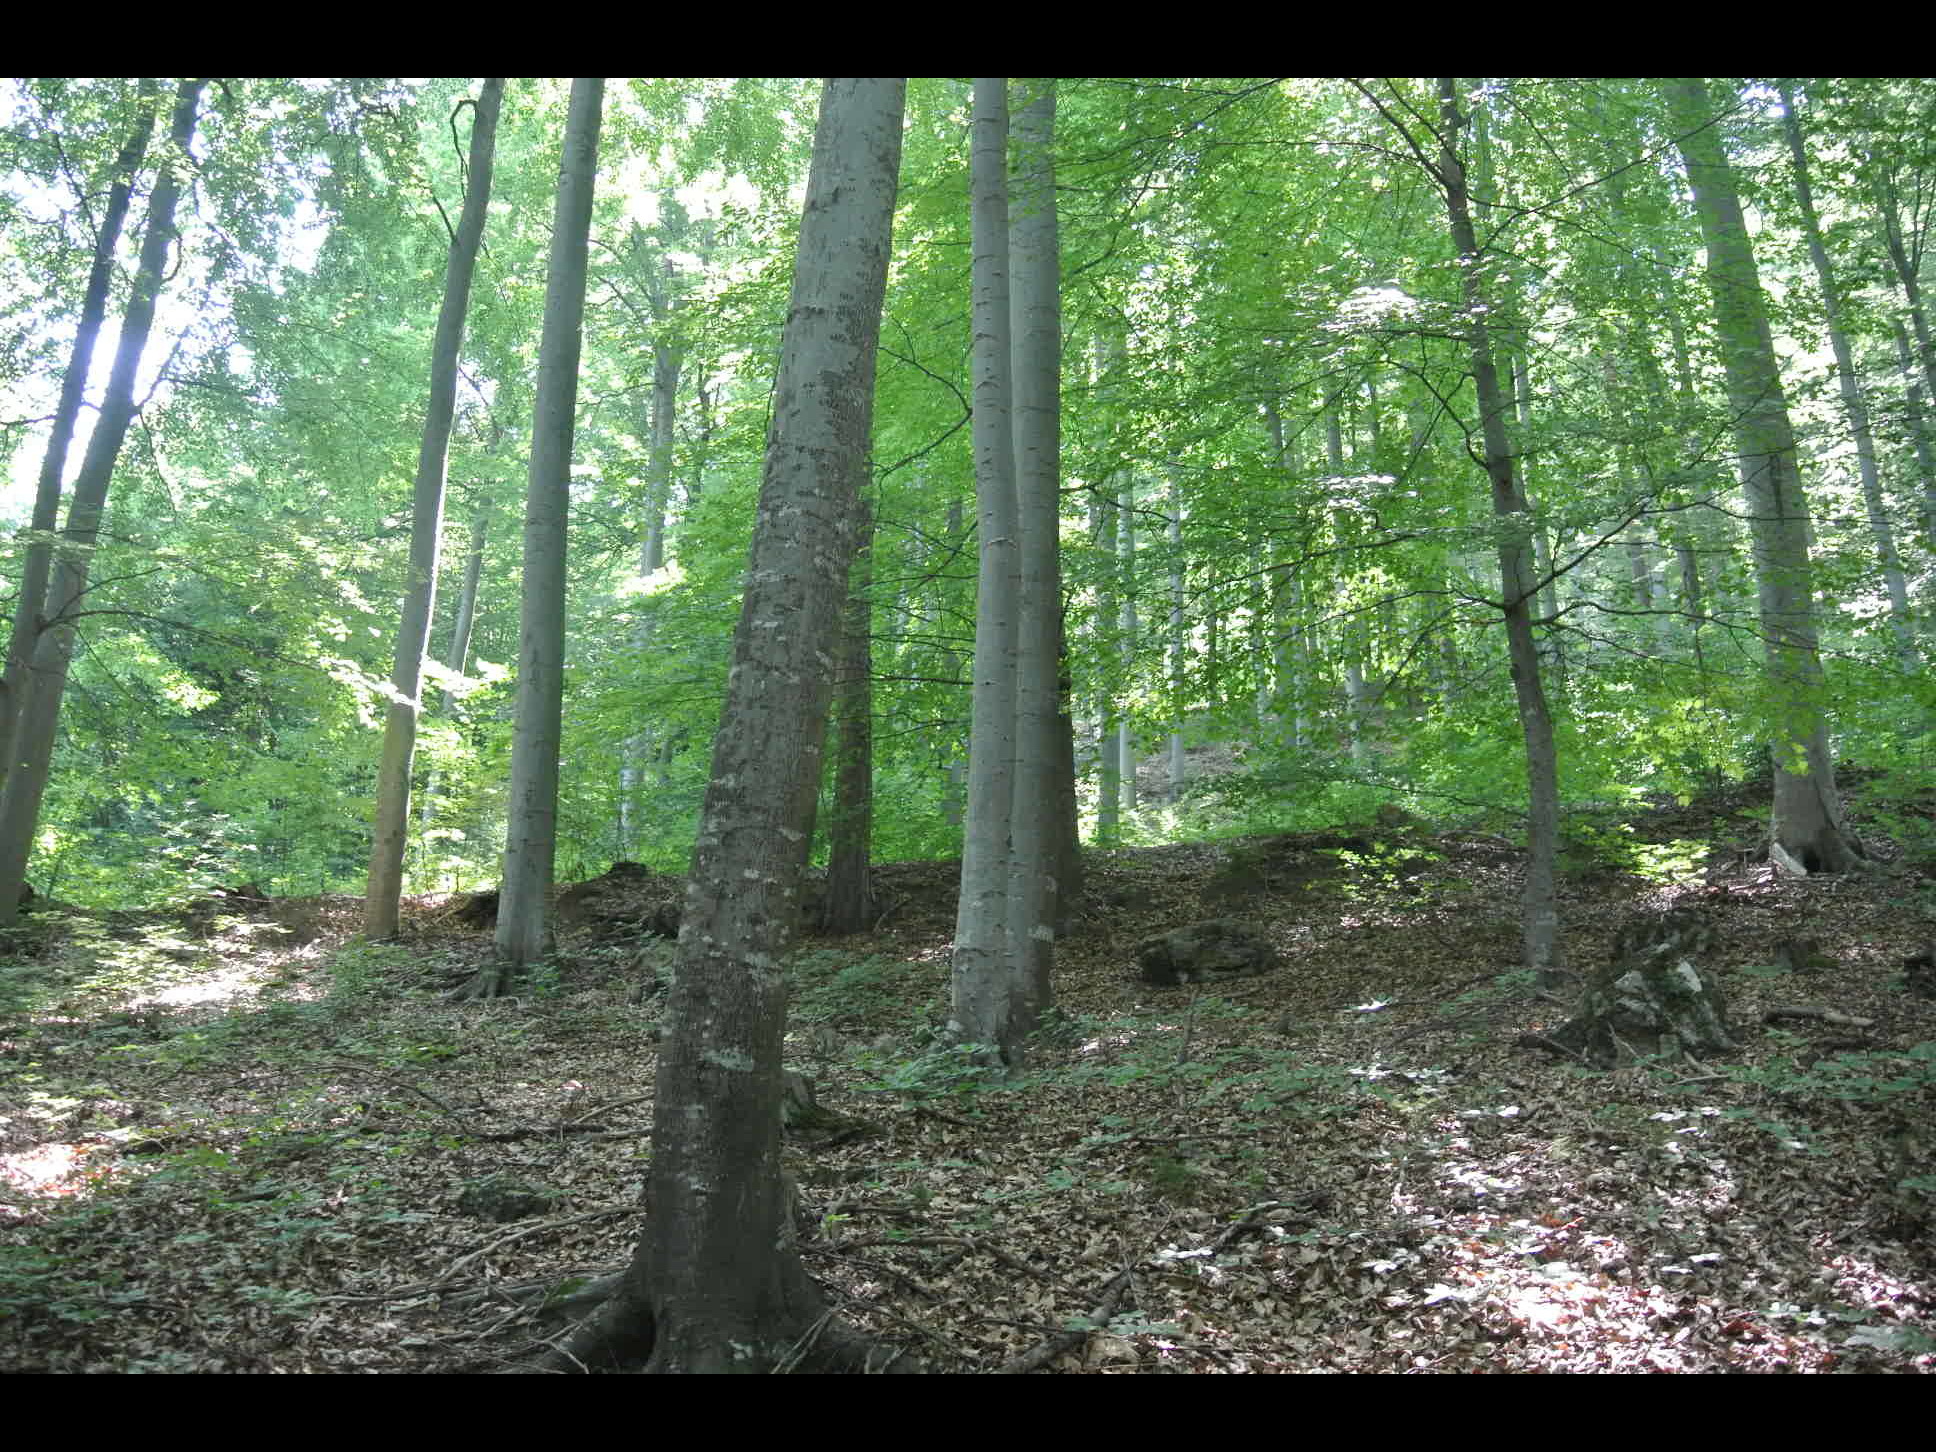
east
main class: Woodland
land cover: Broadleaved woodland
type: beech forest
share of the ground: > 75 %
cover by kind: broadleaved forest trees 80 %, coniferous forest trees 20 %
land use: Forestry
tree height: > 5 m
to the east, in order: Broadleaved woodland; Spruce dominated mixed woodland; Rocks and stones; Spruce dominated mixed woodland; Broadleaved woodland; Tracks
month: July
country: AT
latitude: 47.6553
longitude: 16.1409
